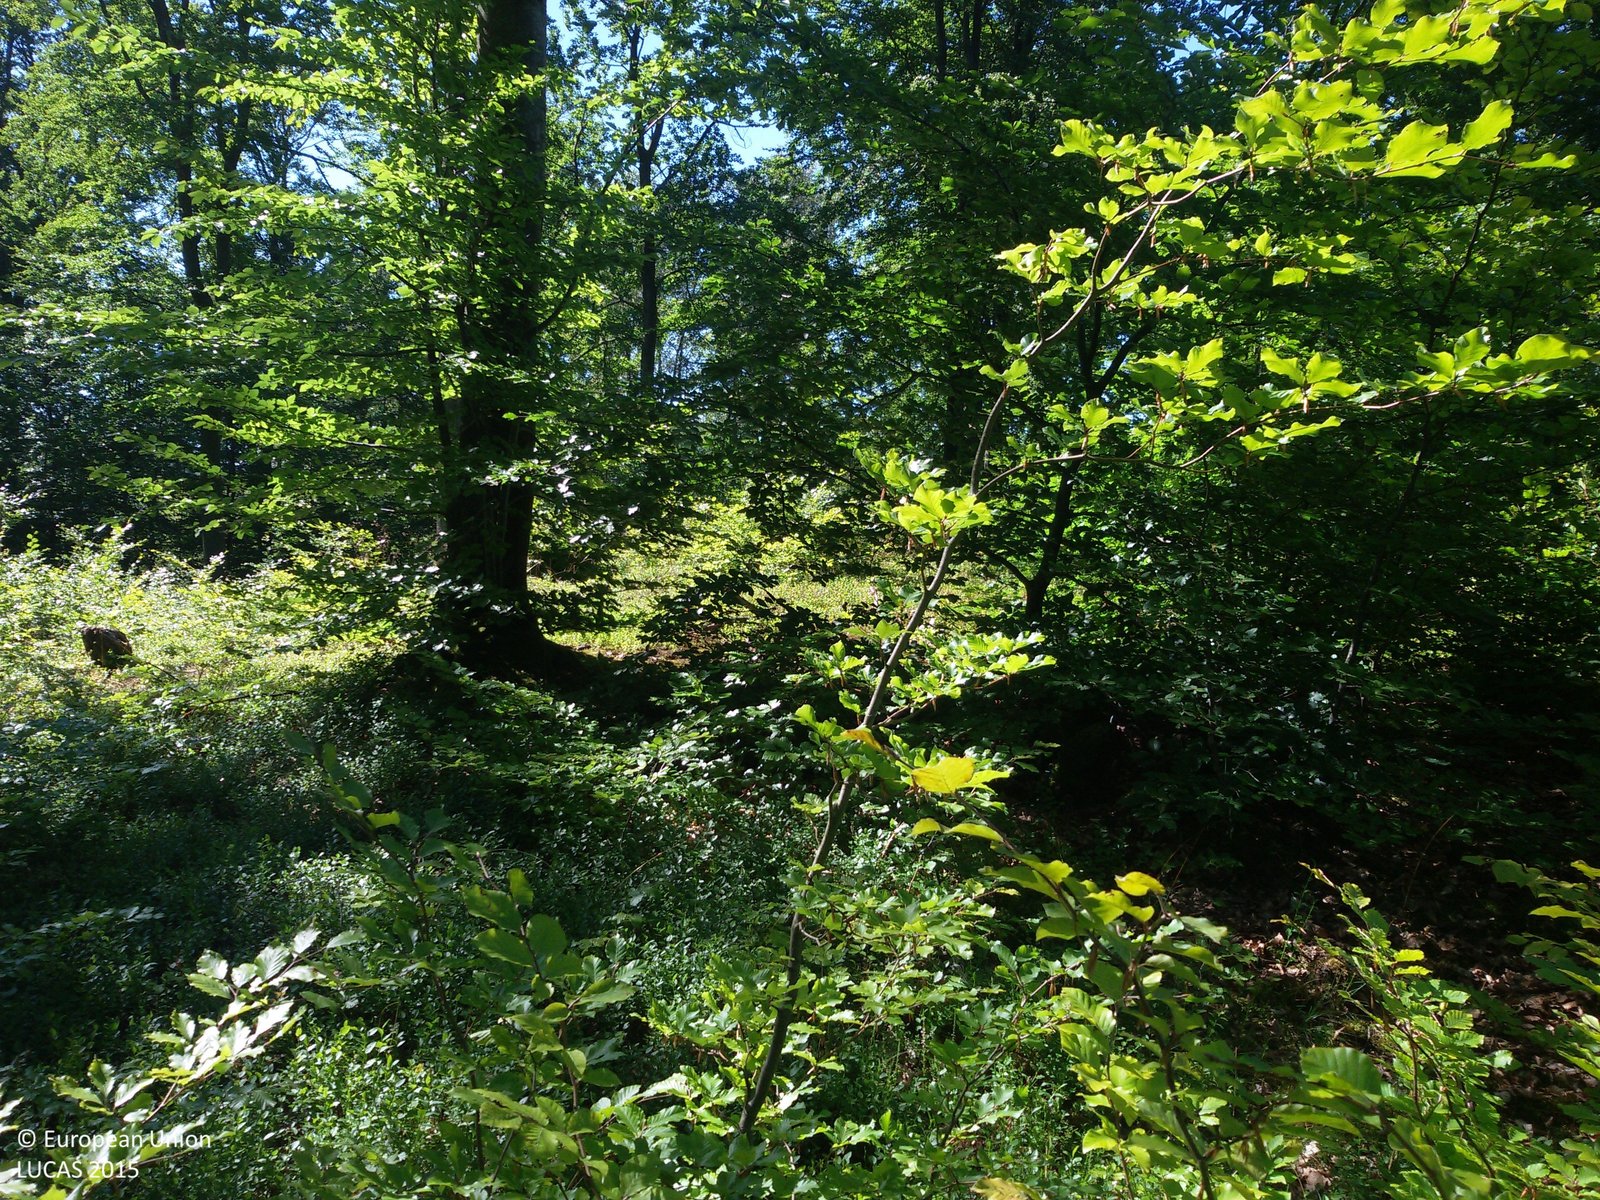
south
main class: Woodland
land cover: Broadleaved woodland
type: mesophytic deciduous forest
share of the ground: > 75 %
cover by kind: broadleaved forest trees 80 %, shrubs 15 %, herbaceous plants 5 %
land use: Forestry
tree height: > 5 m
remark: Nursery
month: August
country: PL
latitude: 54.1252
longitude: 17.2165
